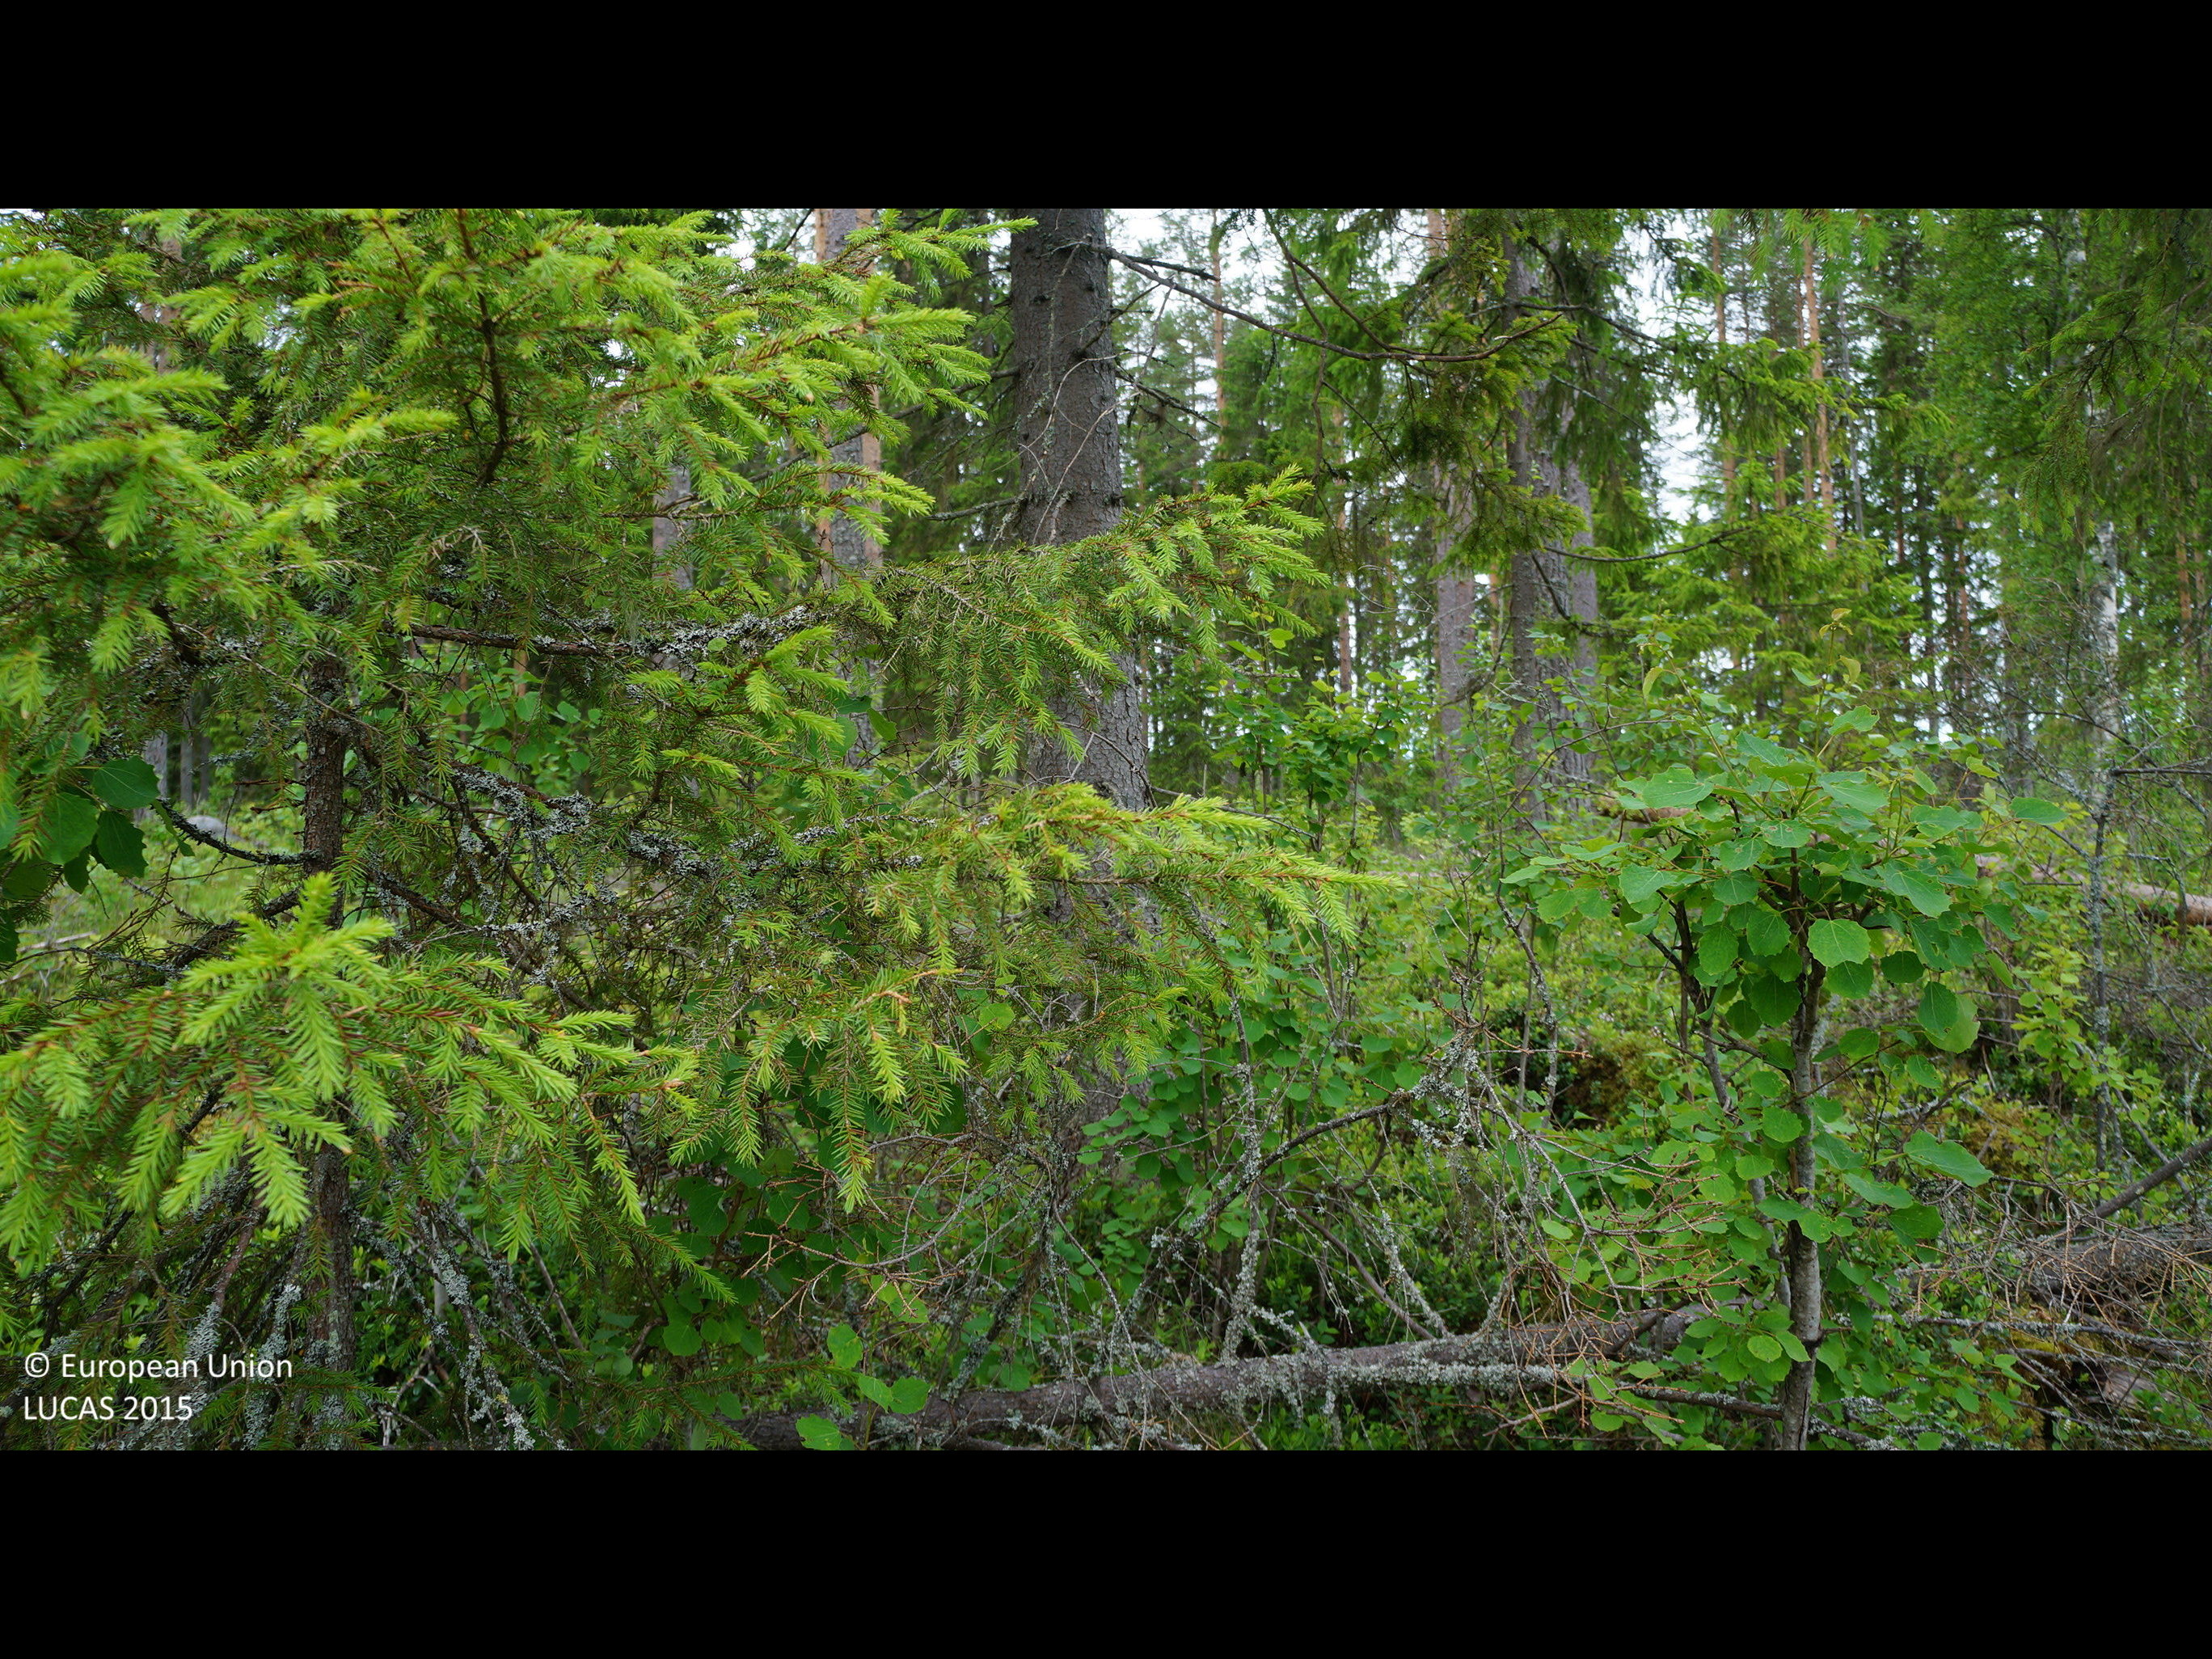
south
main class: Woodland
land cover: Other coniferous woodland
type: boreal forest
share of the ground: 25 - 50 %
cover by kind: shrubs 55 %, coniferous forest trees 35 %, herbaceous plants 5 %, lichens and mosses 5 %
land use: Forestry
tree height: > 5 m
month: July
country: FI
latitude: 64.2796
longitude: 24.5077
